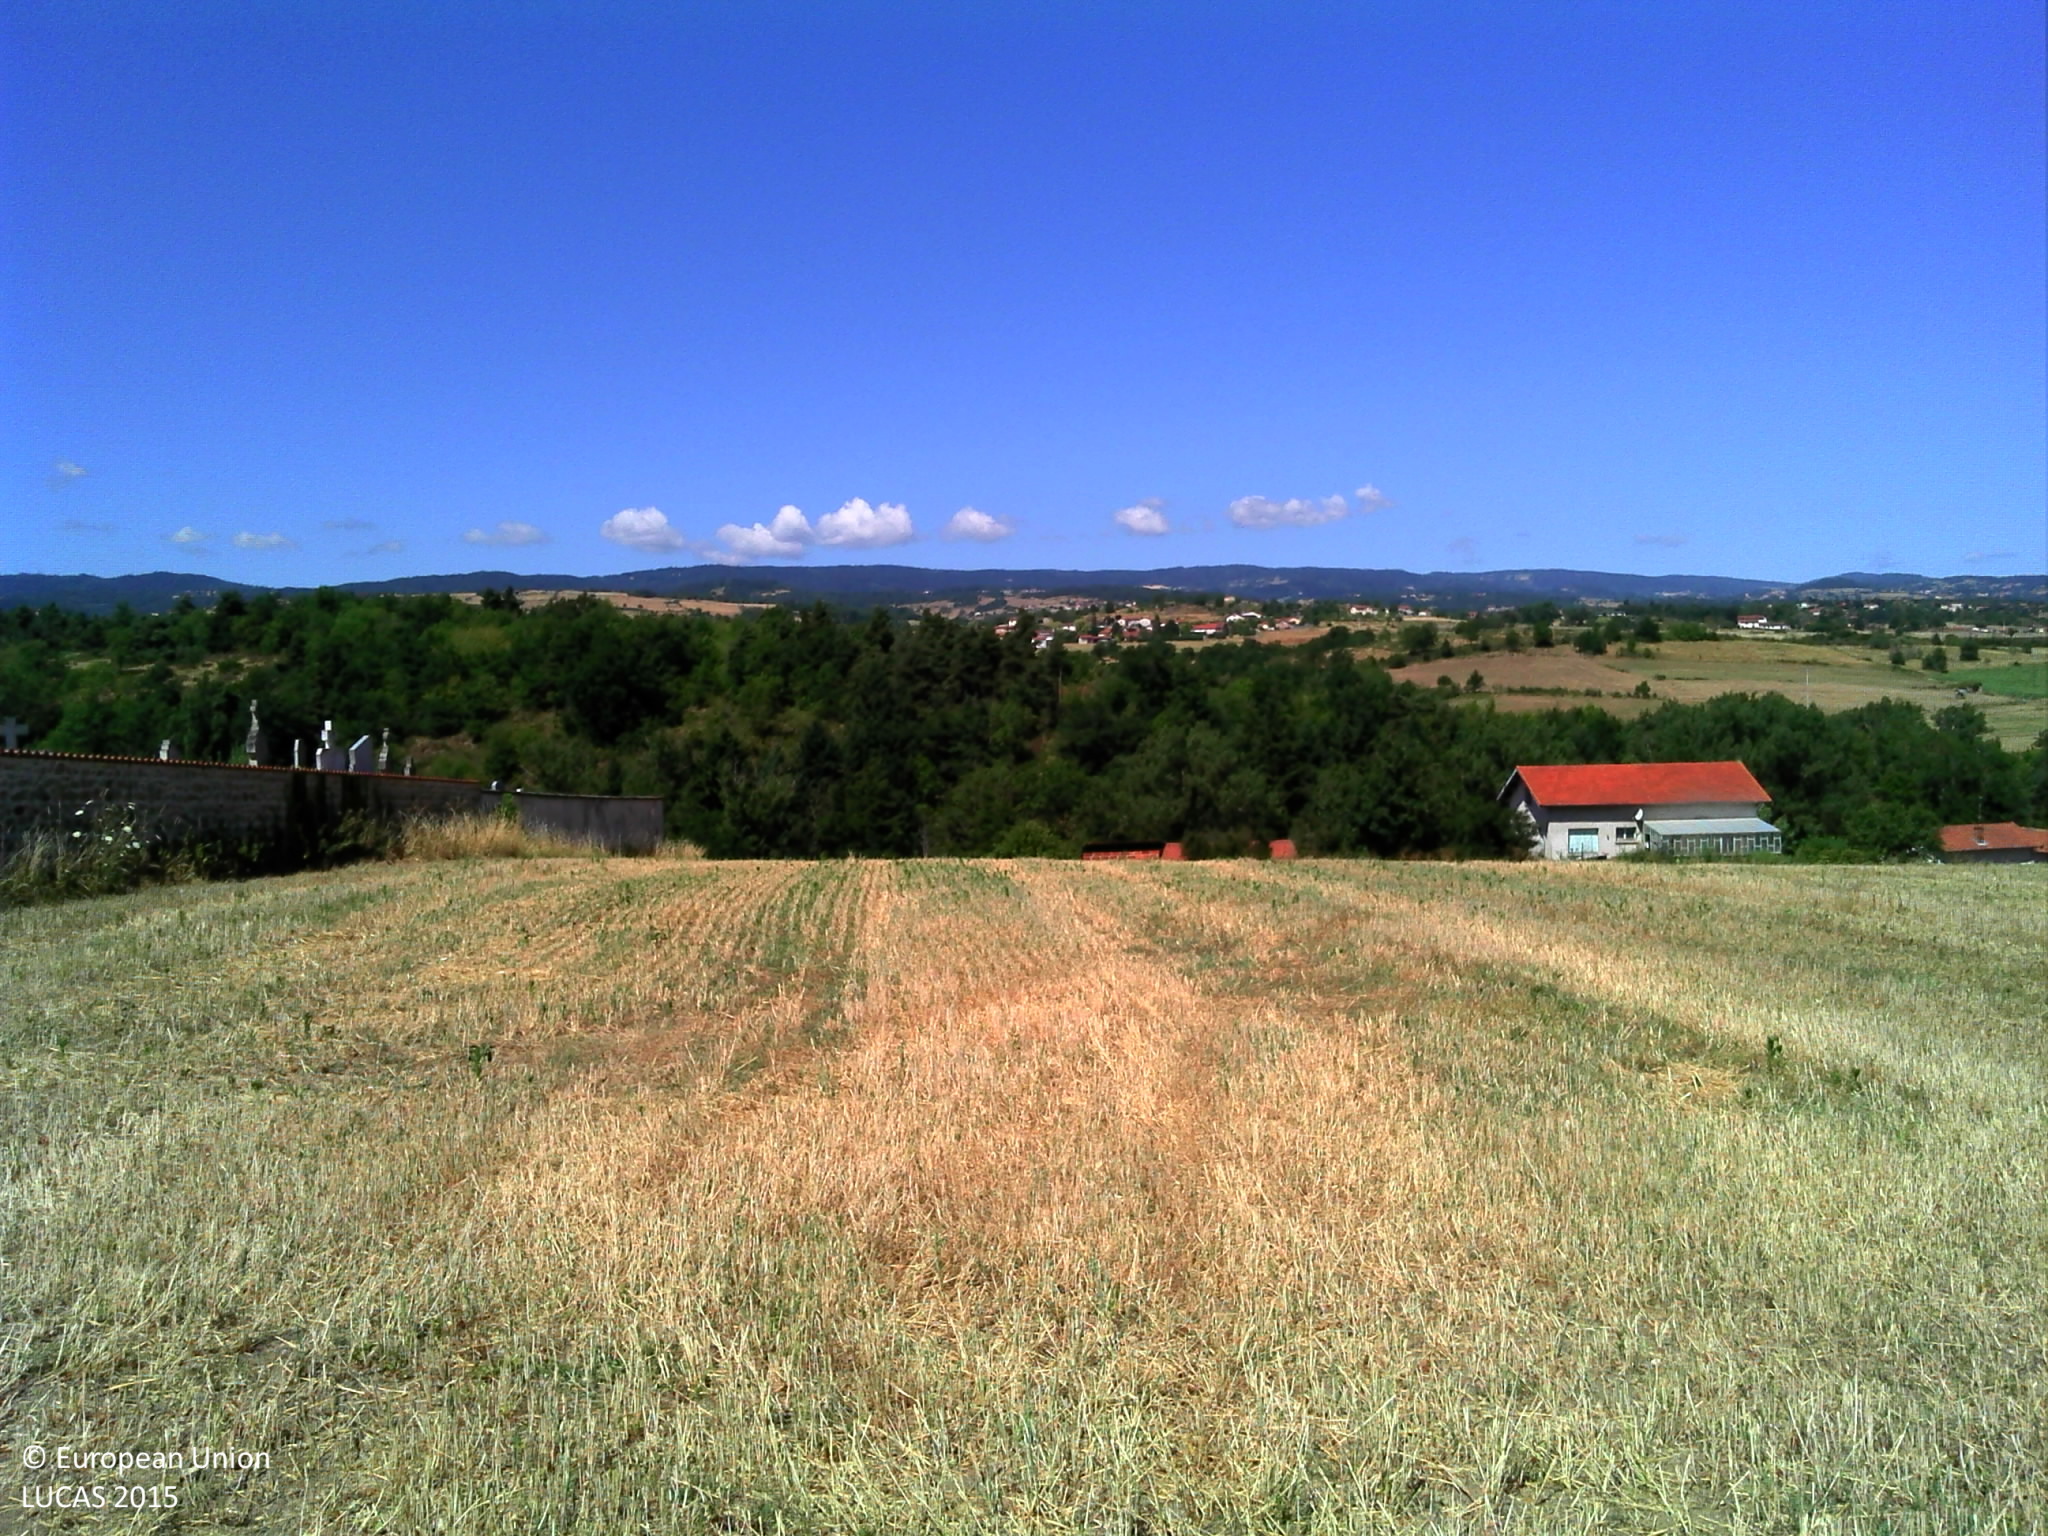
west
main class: Cropland
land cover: Barley
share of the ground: > 75 %
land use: Agriculture (excluding fallow land and kitchen gardens)
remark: Harvested field
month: July
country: FR
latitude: 45.5560
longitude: 4.0974
